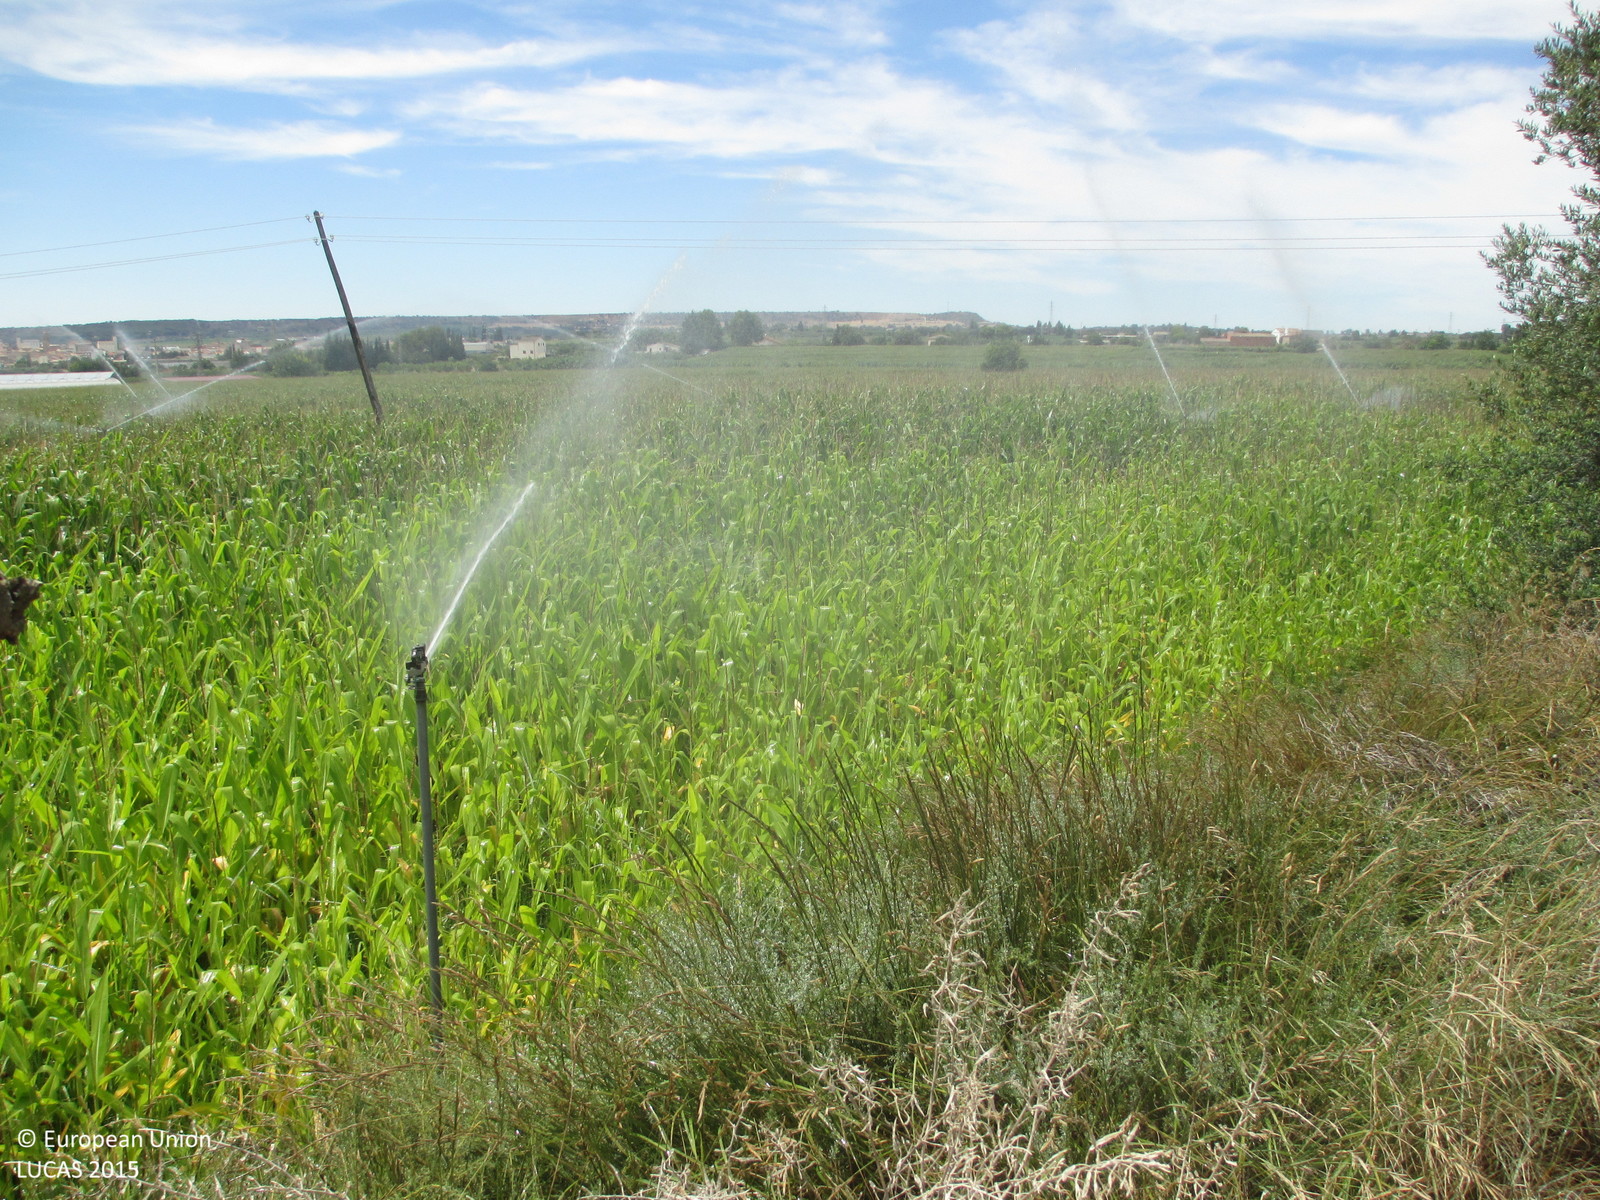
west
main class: Cropland
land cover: Maize
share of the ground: > 75 %
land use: Agriculture (excluding fallow land and kitchen gardens)
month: July
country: ES
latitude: 41.8612
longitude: 0.3107
